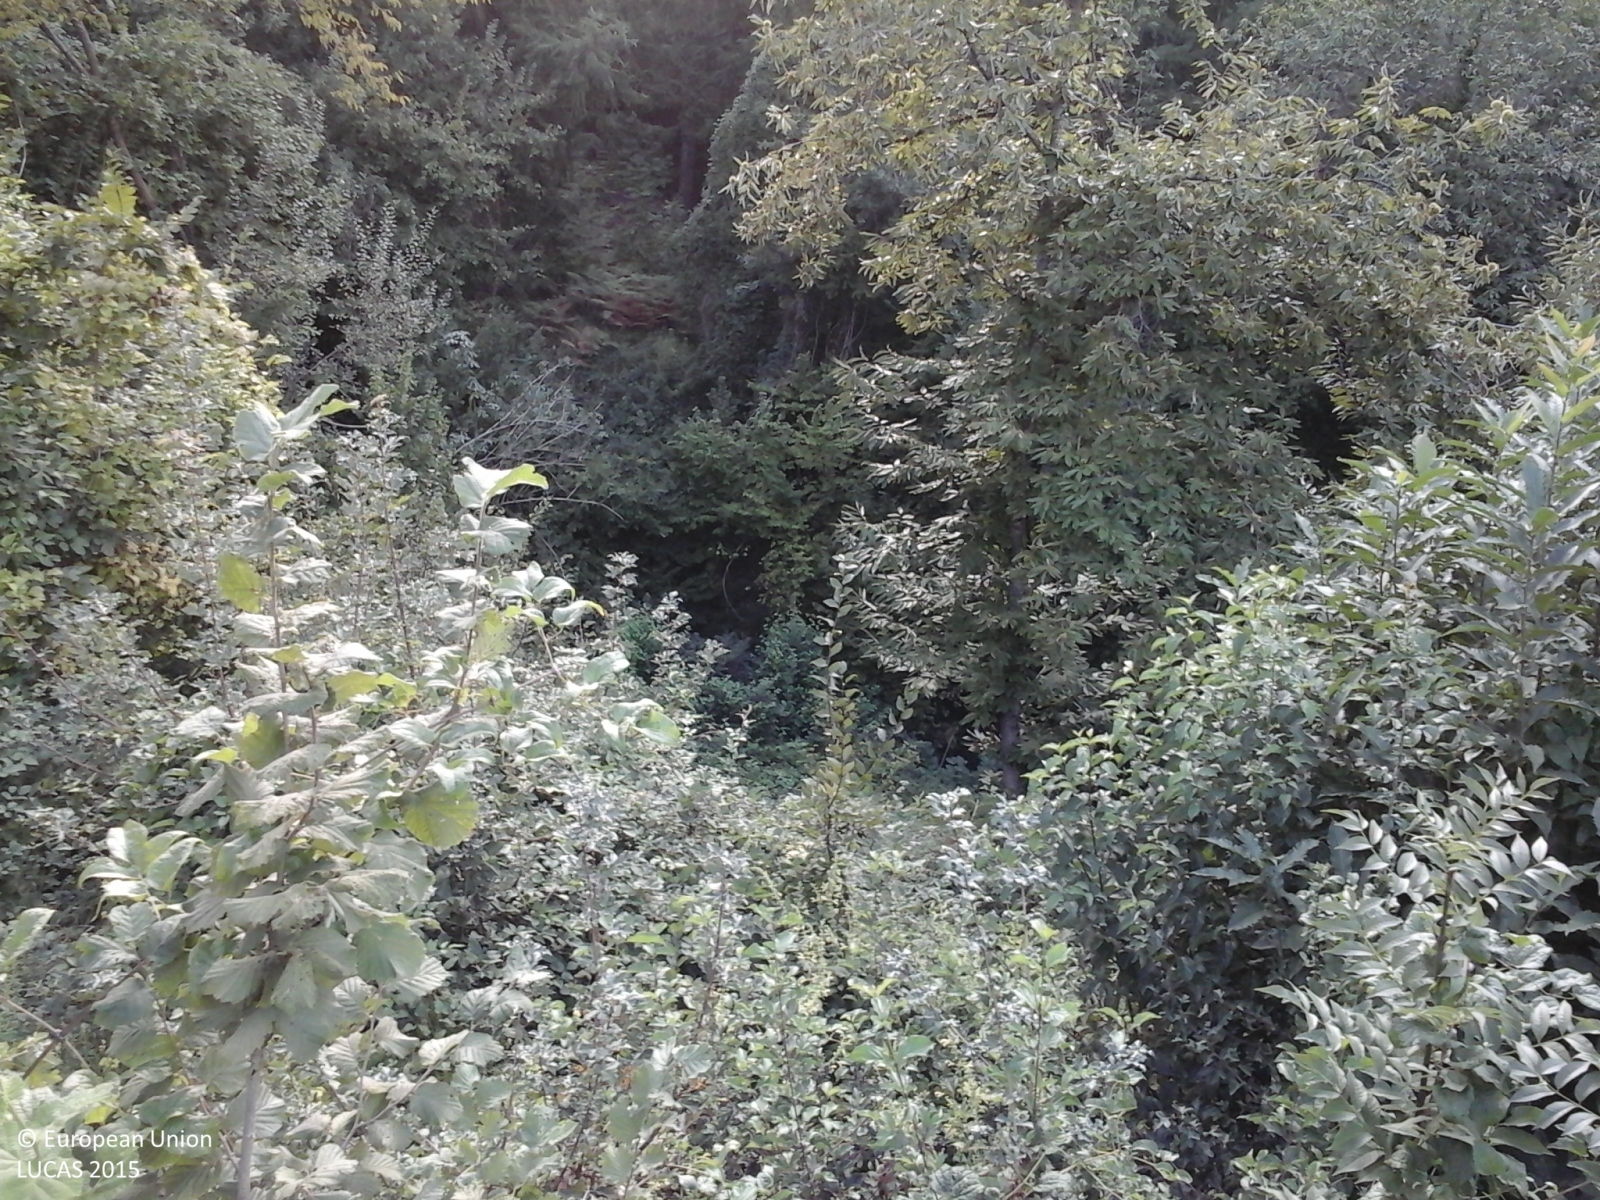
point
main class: Woodland
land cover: Other mixed woodland
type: thermophilous deciduous forest
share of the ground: > 75 %
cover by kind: coniferous forest trees 40 %, broadleaved forest trees 40 %, shrubs 10 %, herbaceous plants 10 %
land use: Semi-natural and natural areas not in use
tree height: > 5 m
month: September
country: IT
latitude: 42.7383
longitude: 13.4955
